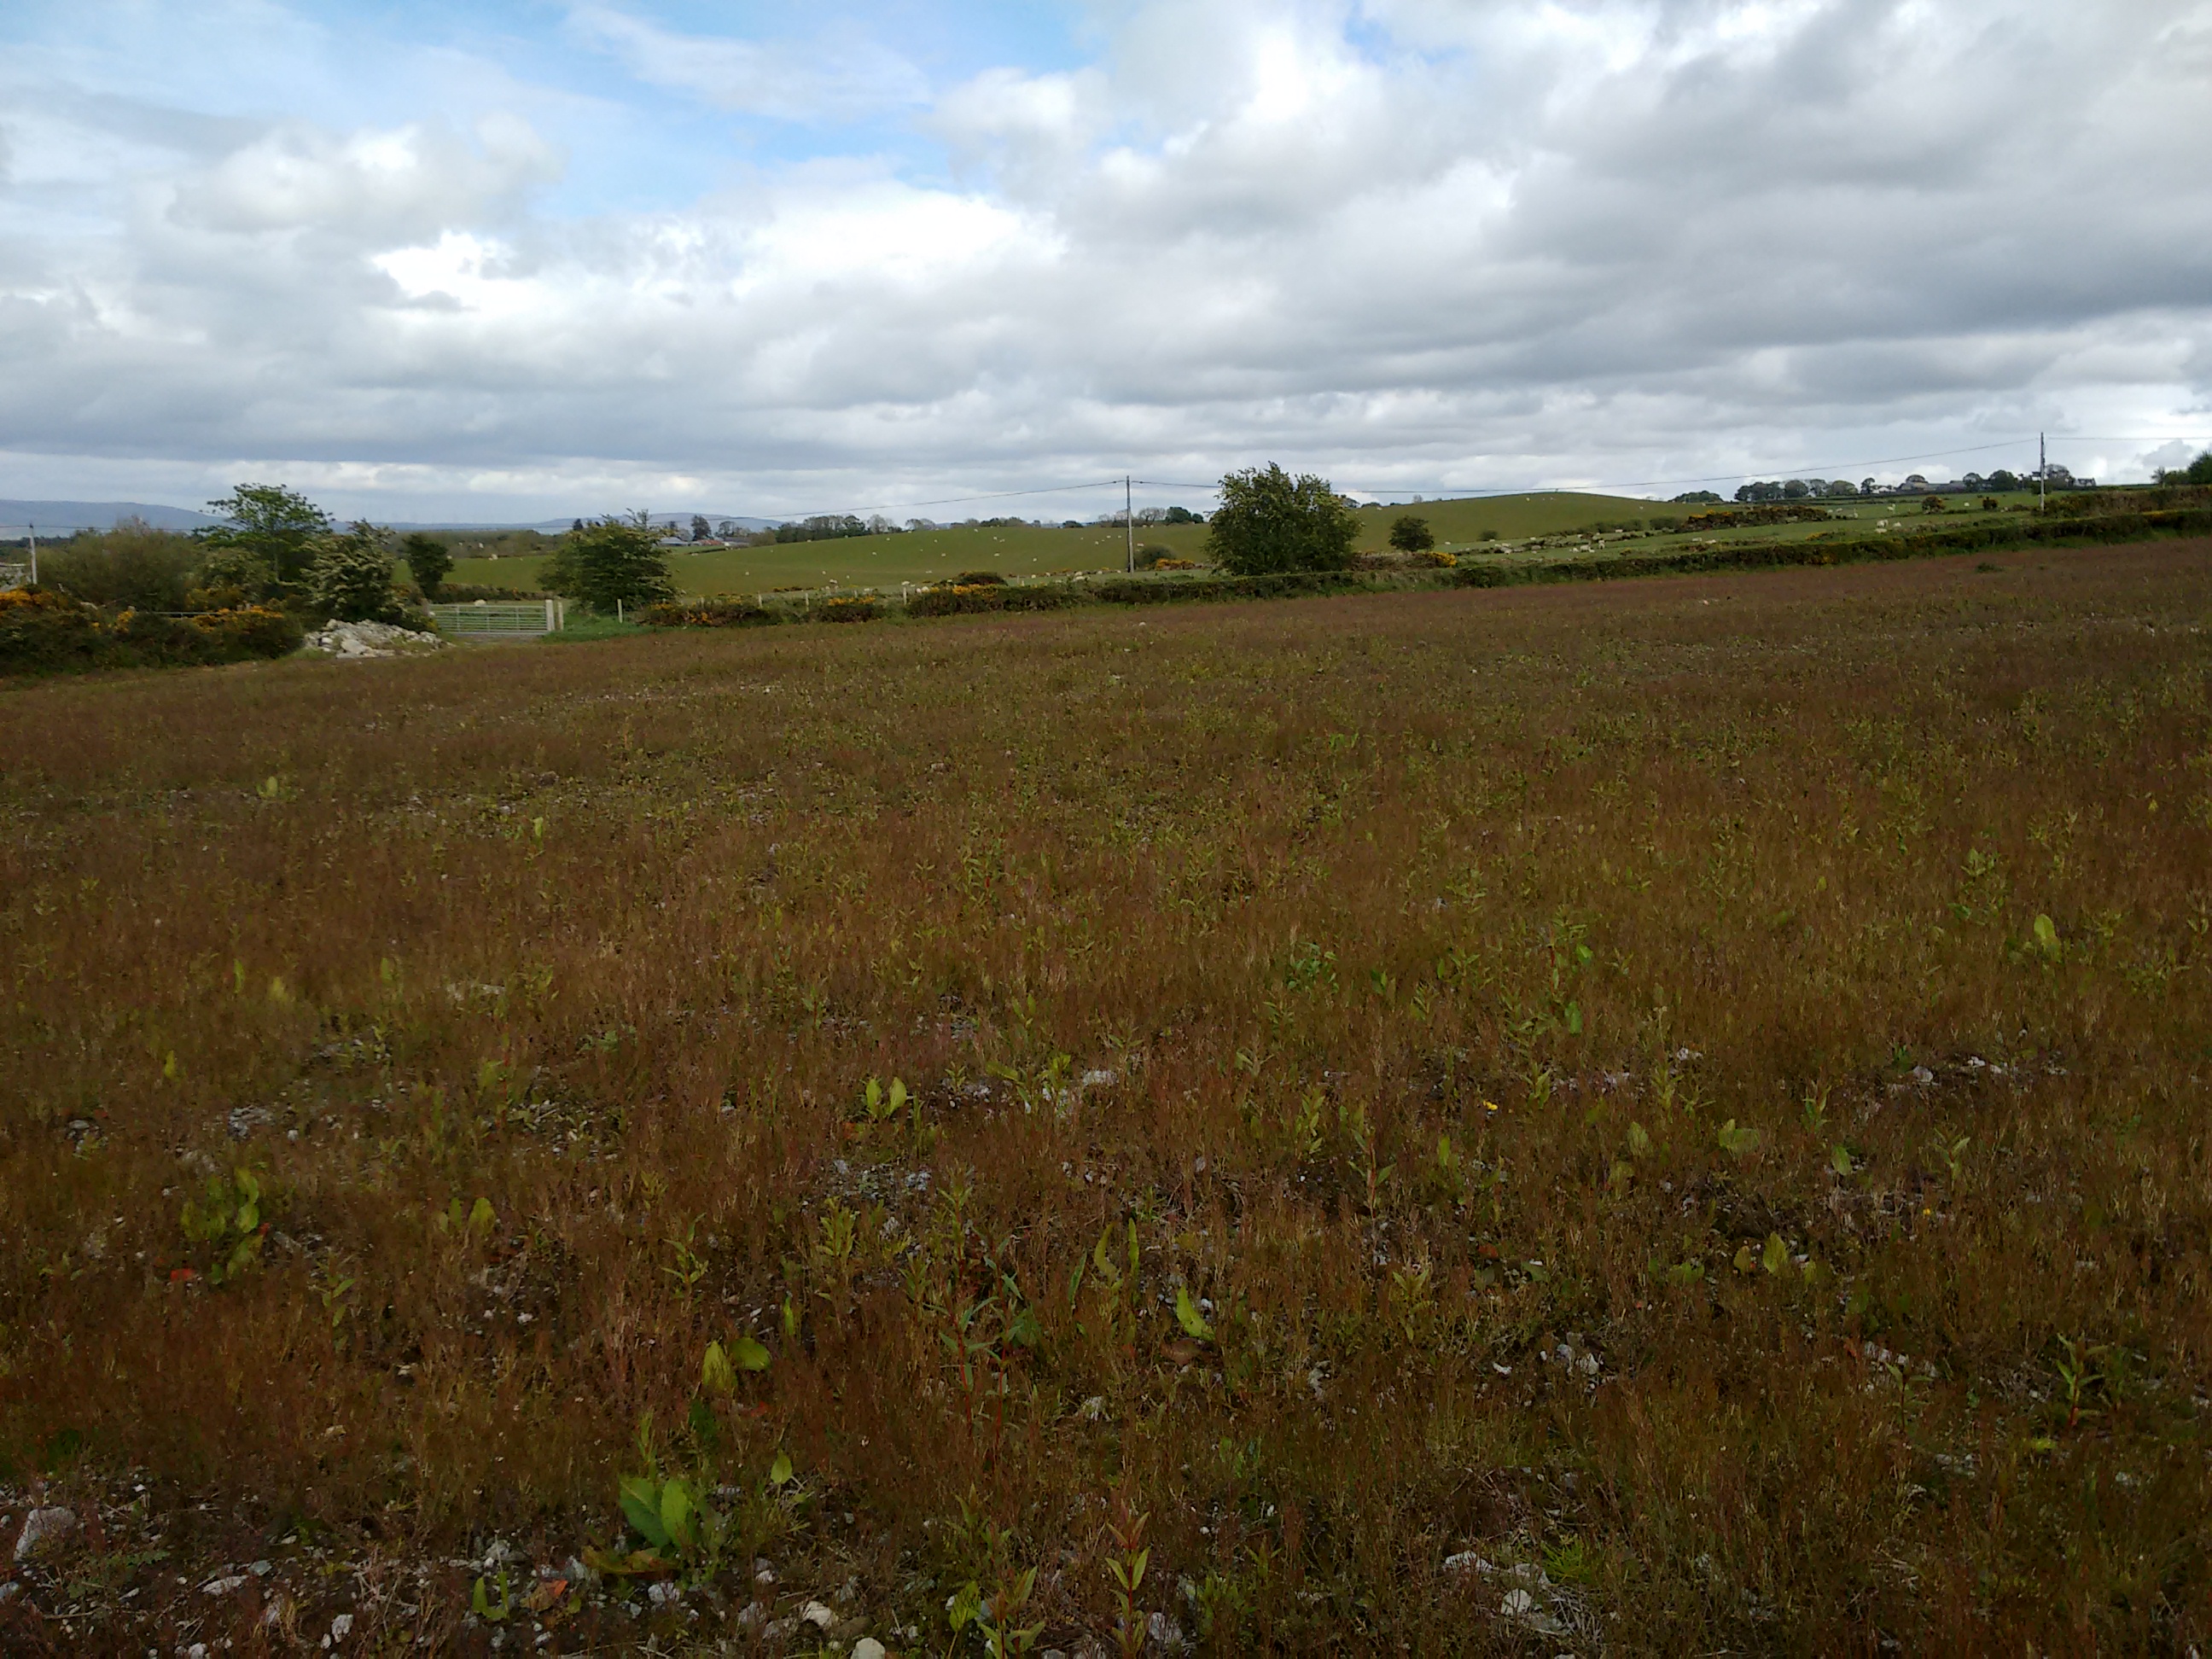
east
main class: Grassland
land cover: Spontaneously vegetated surfaces
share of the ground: > 75 %
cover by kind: herbaceous plants 100 %
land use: Agriculture (excluding fallow land and kitchen gardens)
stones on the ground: 25 - 50 %
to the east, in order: Spontaneously vegetated surfaces; Managed hedges; Fences; Paved roads, cycling and walking lanes; Grass margins; Fences; Managed hedges; Fences; Grassland without tree/shrub cover
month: June
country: GB
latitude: 55.0289
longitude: -7.0831
